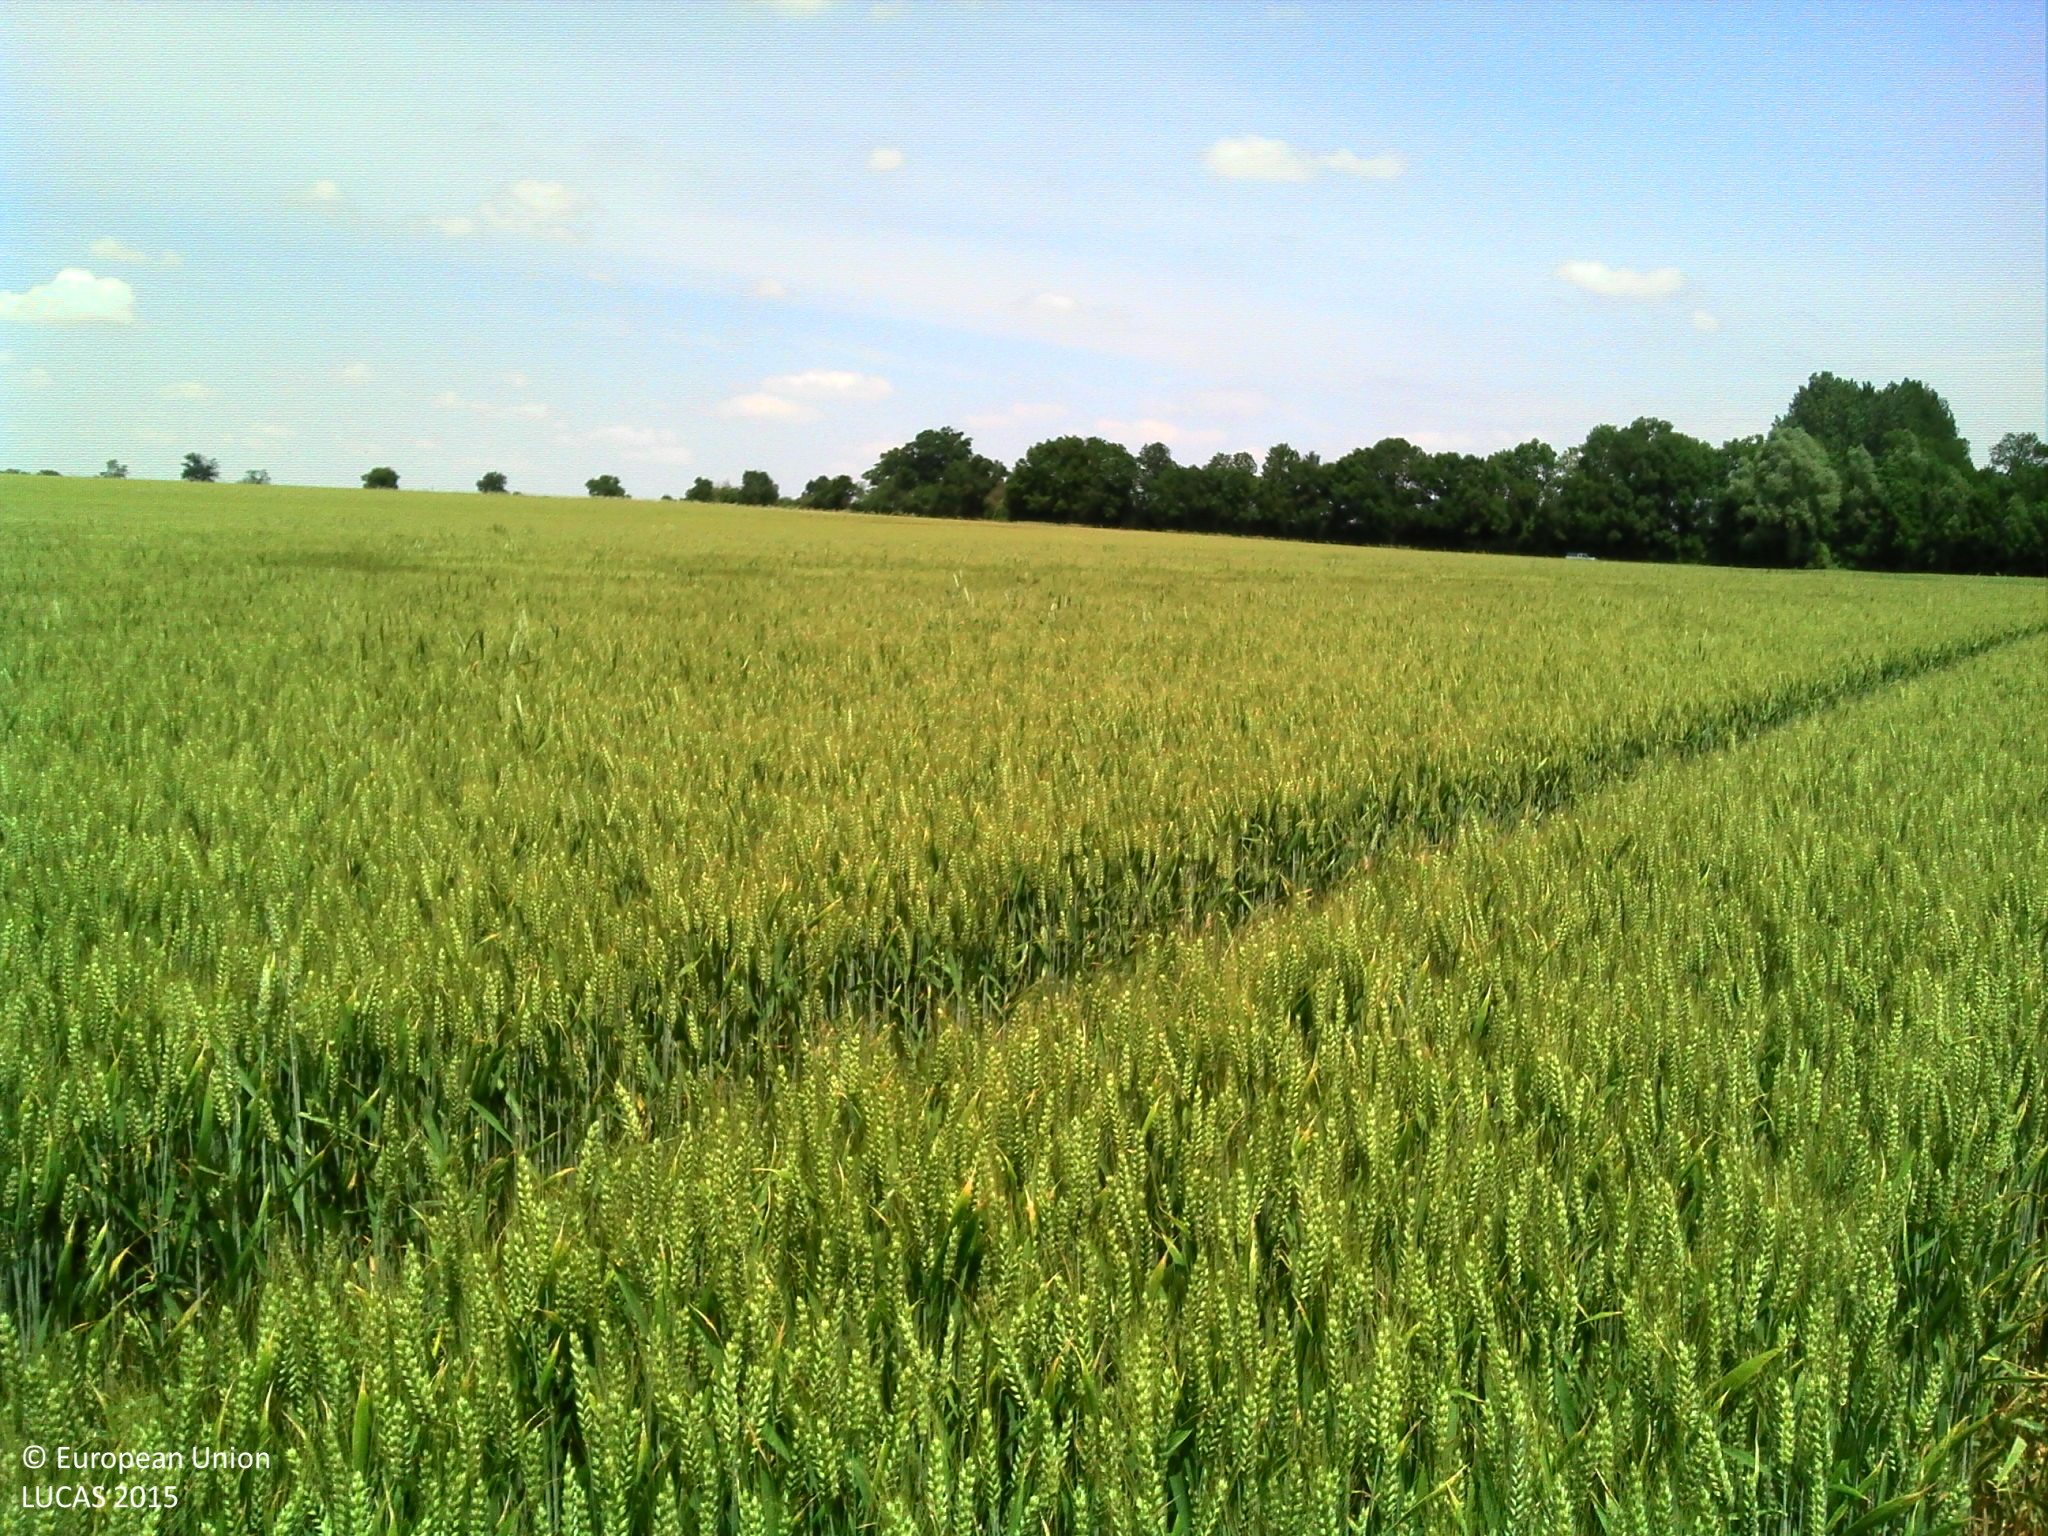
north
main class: Cropland
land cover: Common wheat
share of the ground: > 75 %
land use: Agriculture (excluding fallow land and kitchen gardens)
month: June
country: FR
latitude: 46.9497
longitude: 2.6761
